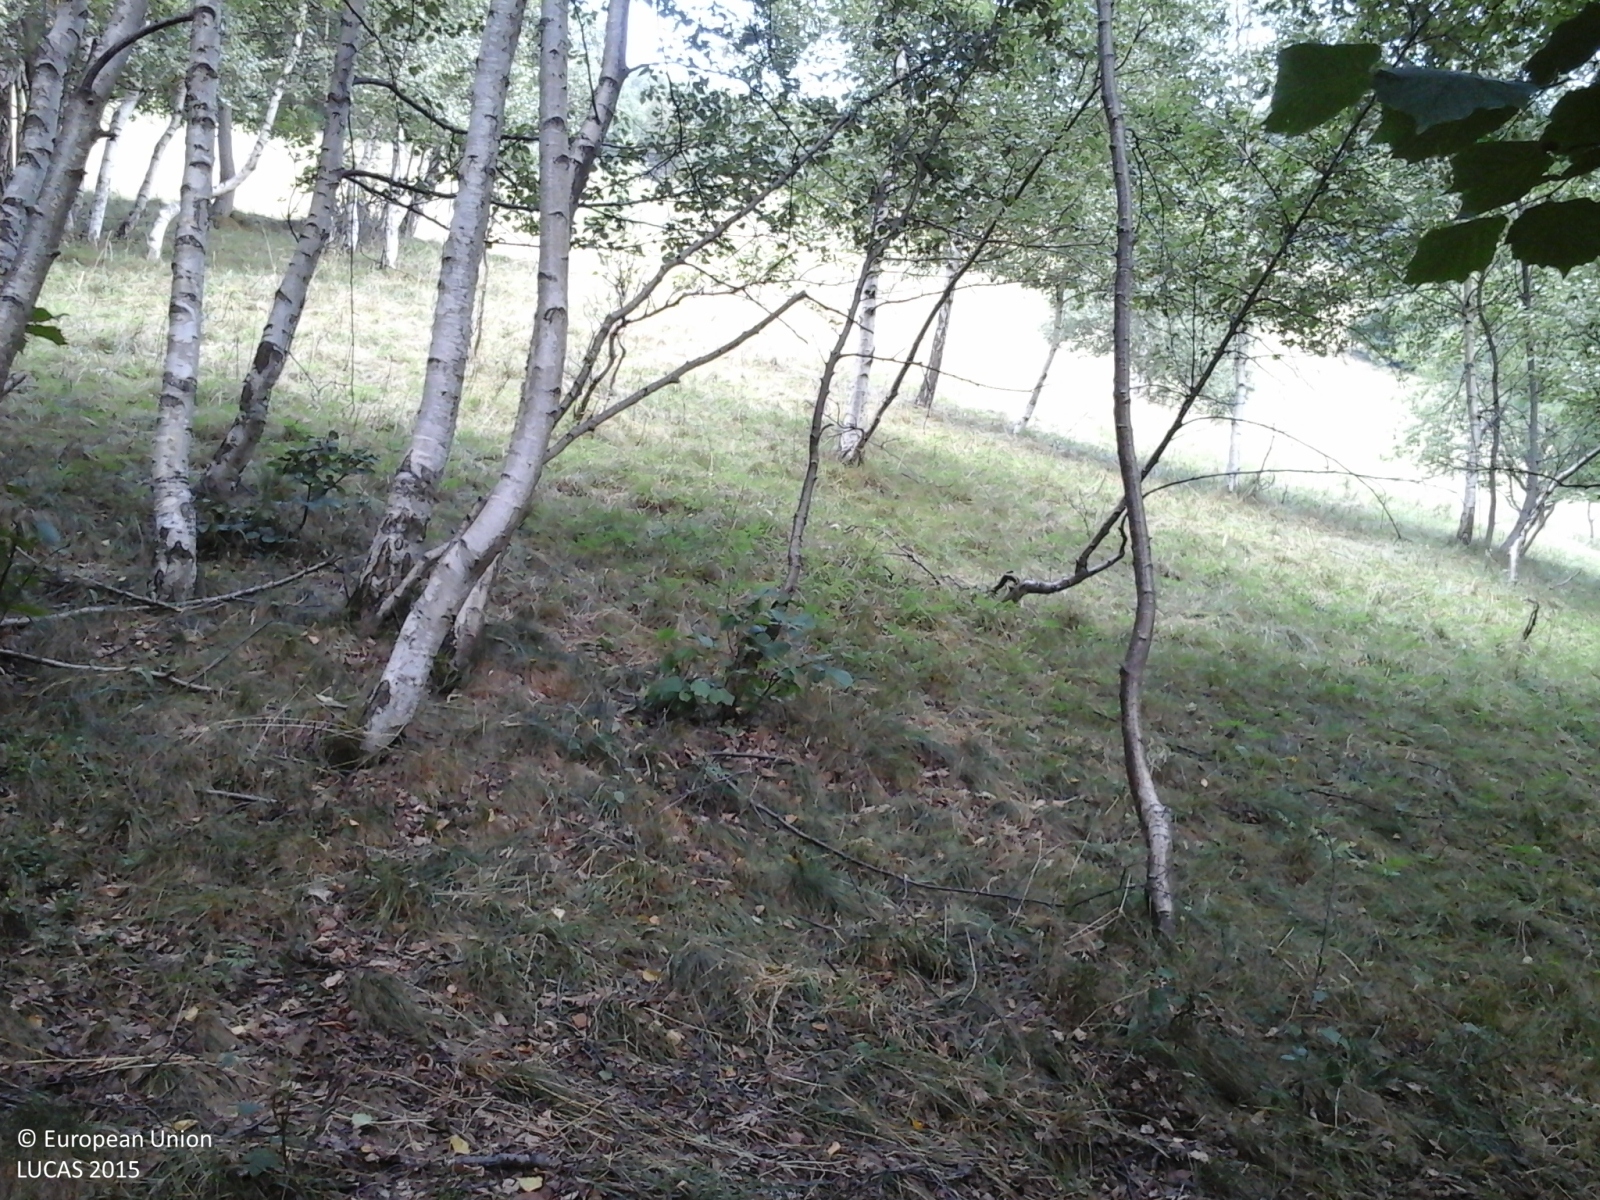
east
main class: Woodland
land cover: Broadleaved woodland
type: mountainous beech forest
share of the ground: > 75 %
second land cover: Grassland without tree/shrub cover
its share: > 75 %
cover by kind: broadleaved forest trees 70 %, herbaceous plants 30 %
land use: Forestry
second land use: Agriculture (excluding fallow land and kitchen gardens)
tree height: > 5 m
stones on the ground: < 10 %
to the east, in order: Broadleaved woodland; Grassland without tree/shrub cover; Tracks; Grassland without tree/shrub cover; Tracks; Broadleaved woodland; Tracks; Broadleaved woodland
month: July
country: IT
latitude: 44.6741
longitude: 7.2174
